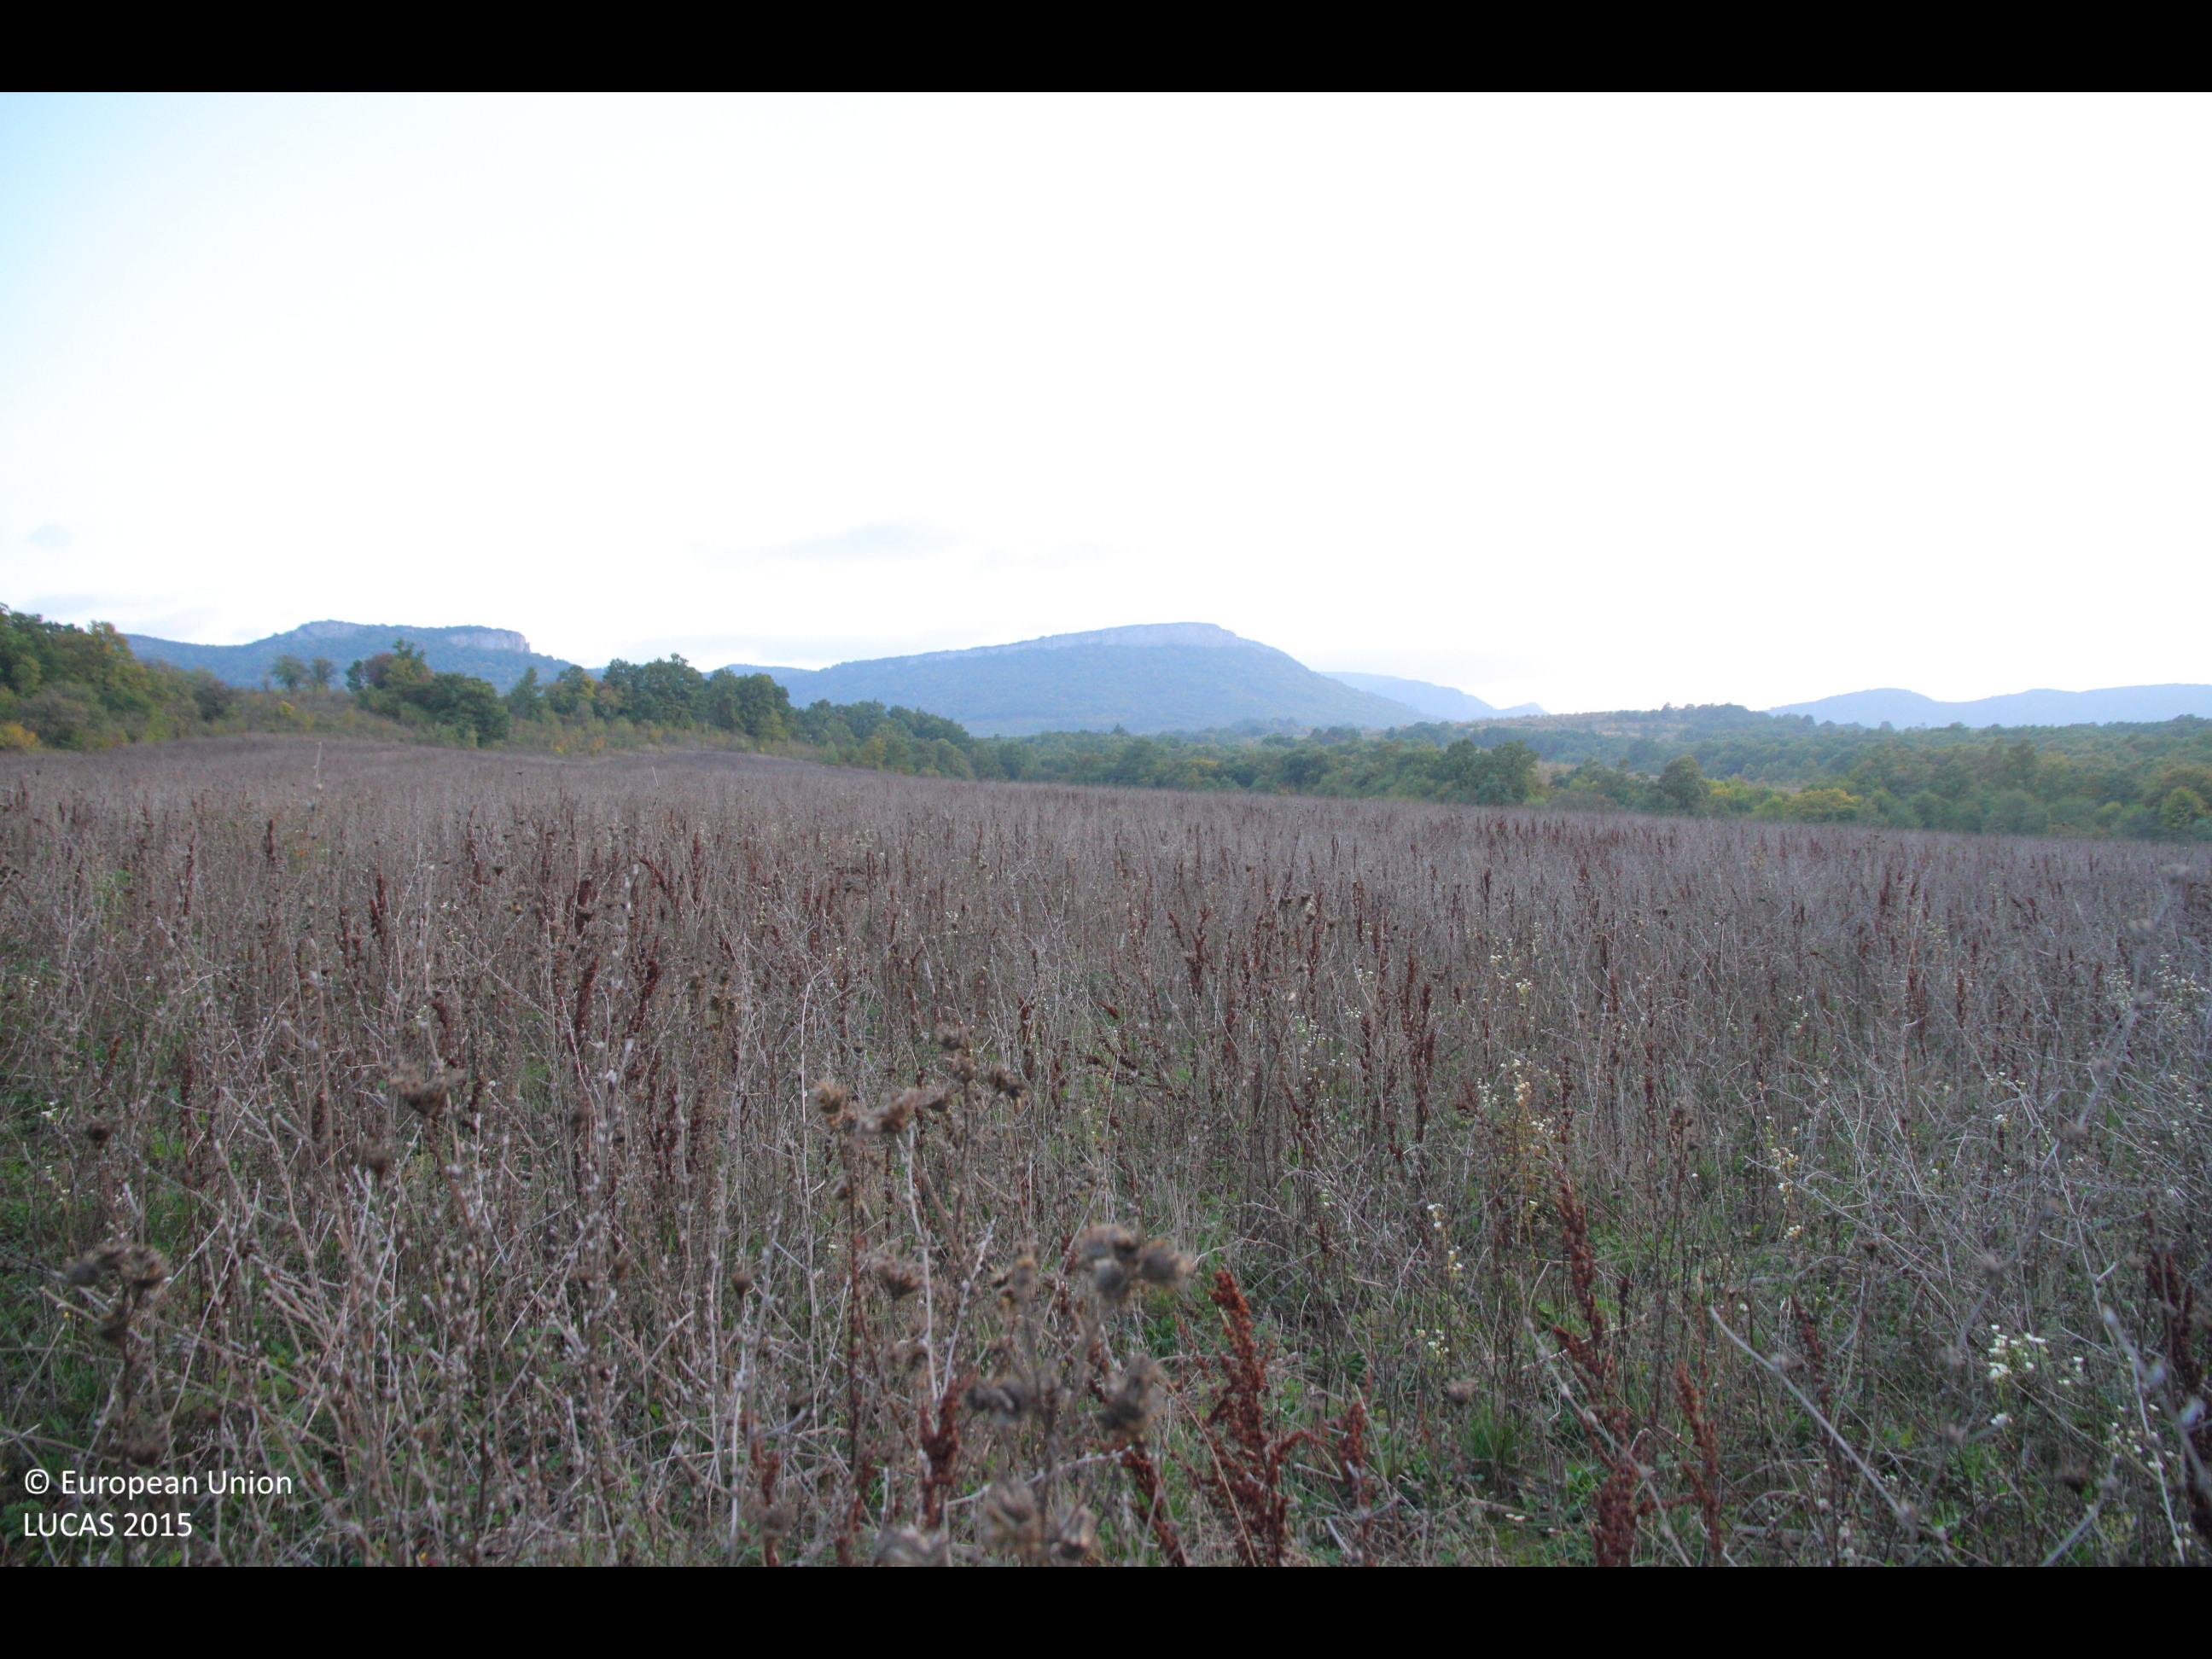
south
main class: Grassland
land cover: Spontaneously vegetated surfaces
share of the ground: > 75 %
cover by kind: herbaceous plants 100 %
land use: Agriculture (excluding fallow land and kitchen gardens)
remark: Harvested field
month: October
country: BG
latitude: 42.9729
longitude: 26.9946
